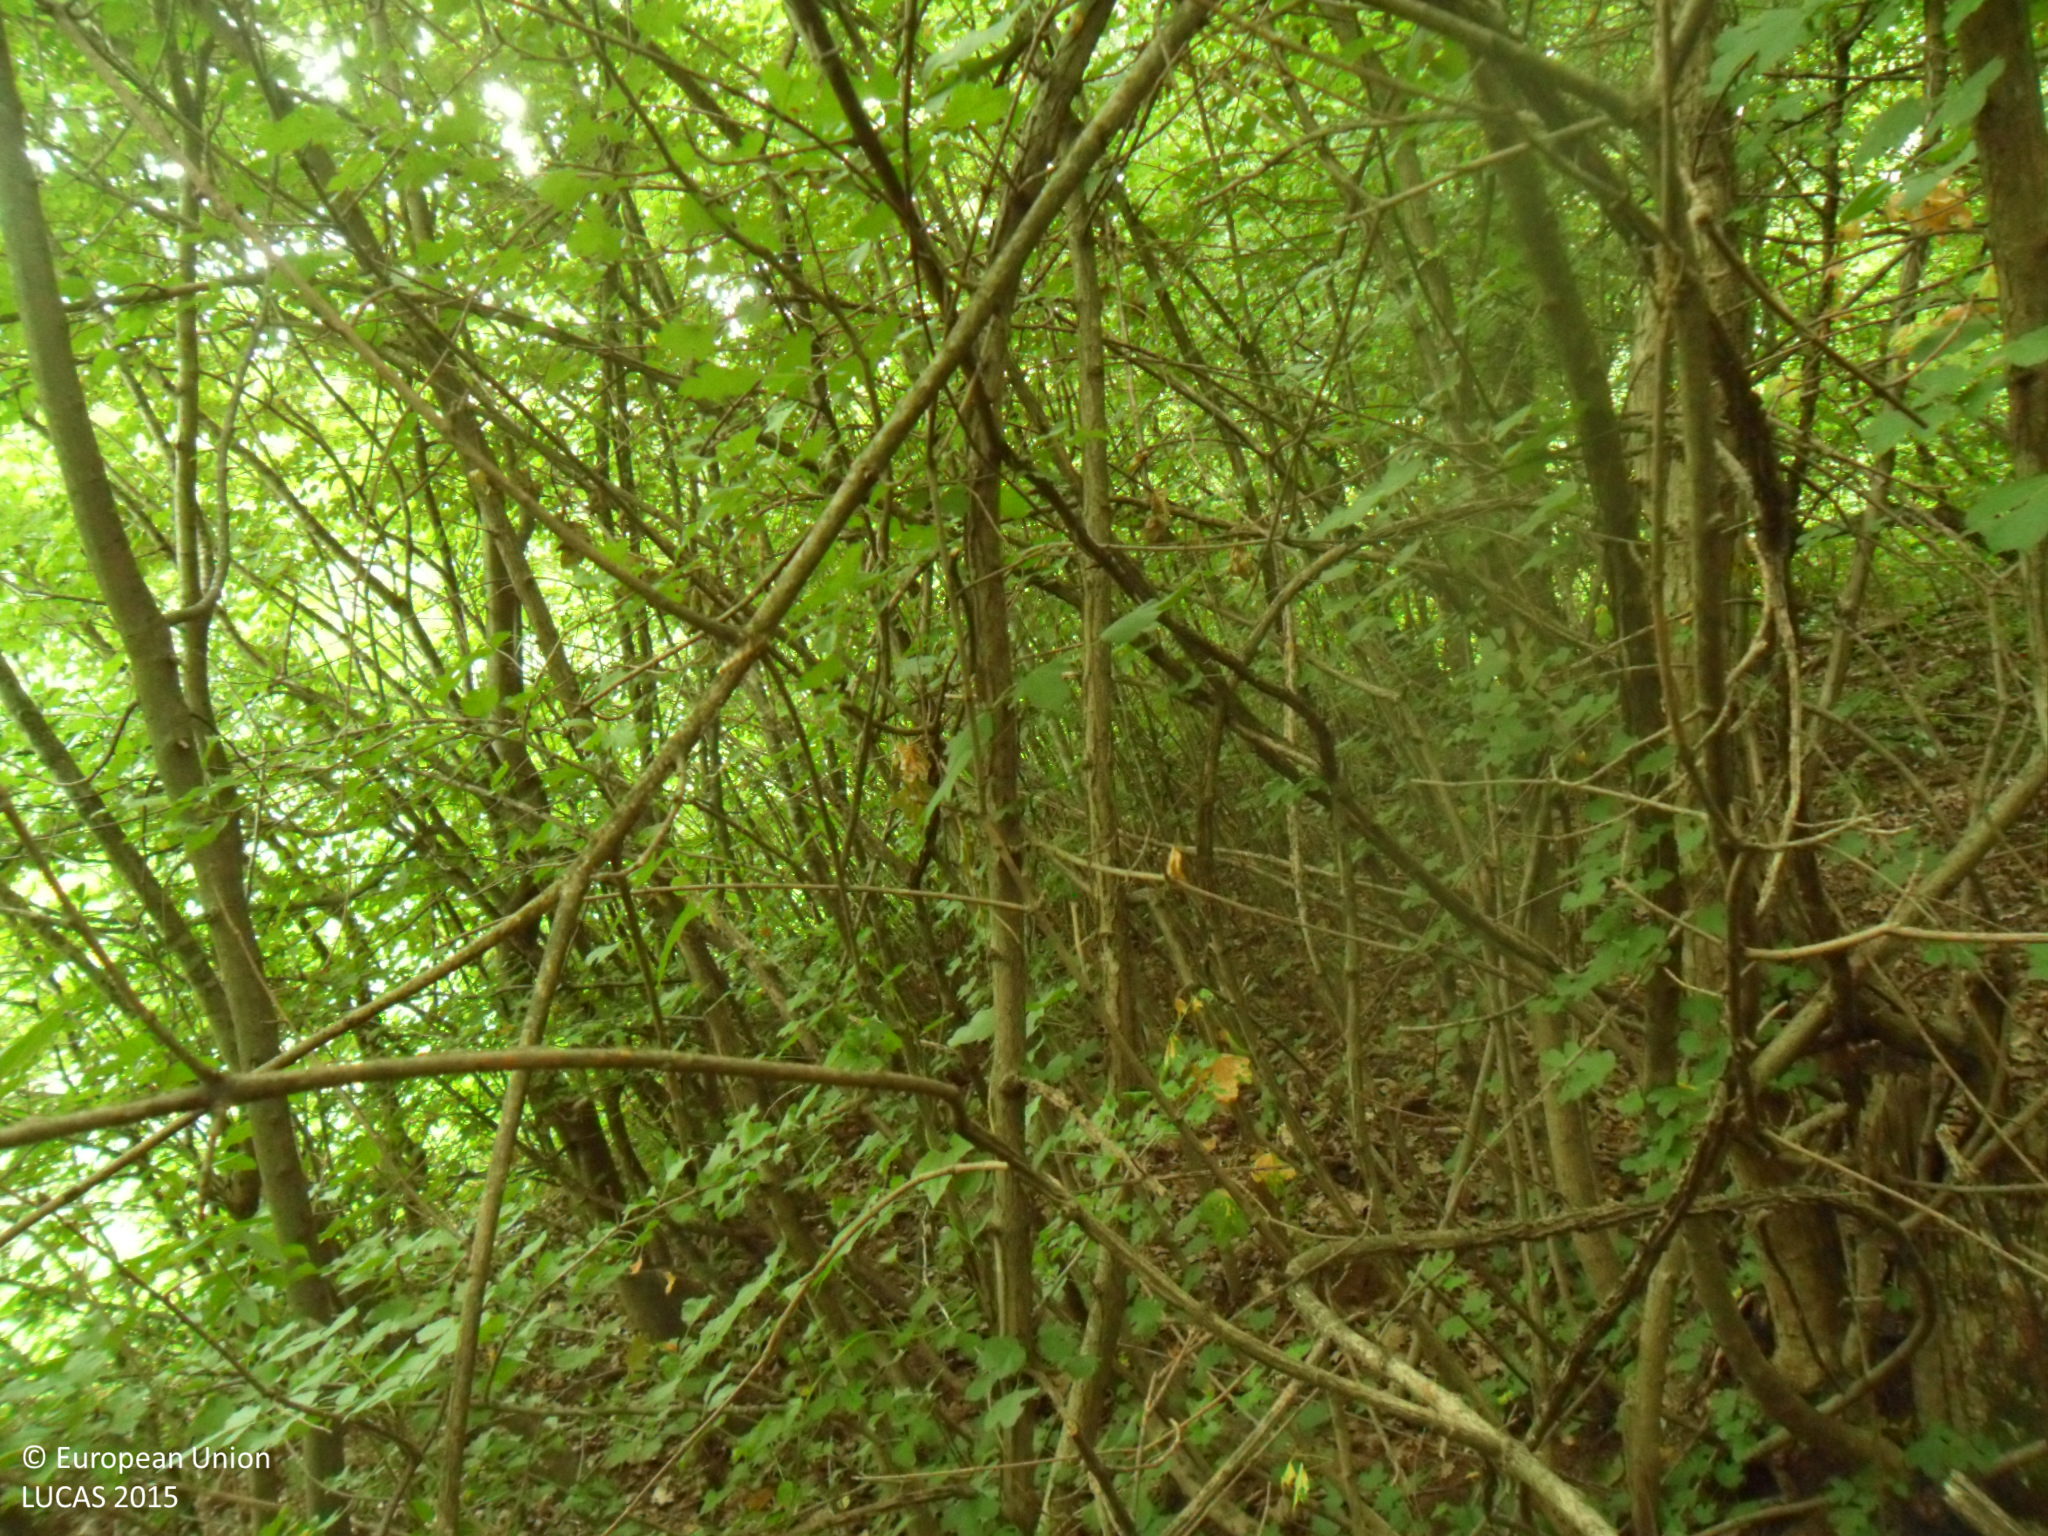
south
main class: Woodland
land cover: Broadleaved woodland
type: mesophytic deciduous forest
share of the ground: > 75 %
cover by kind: broadleaved forest trees 100 %
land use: Forestry
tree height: > 5 m
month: June
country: BG
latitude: 43.0943
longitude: 26.9294
